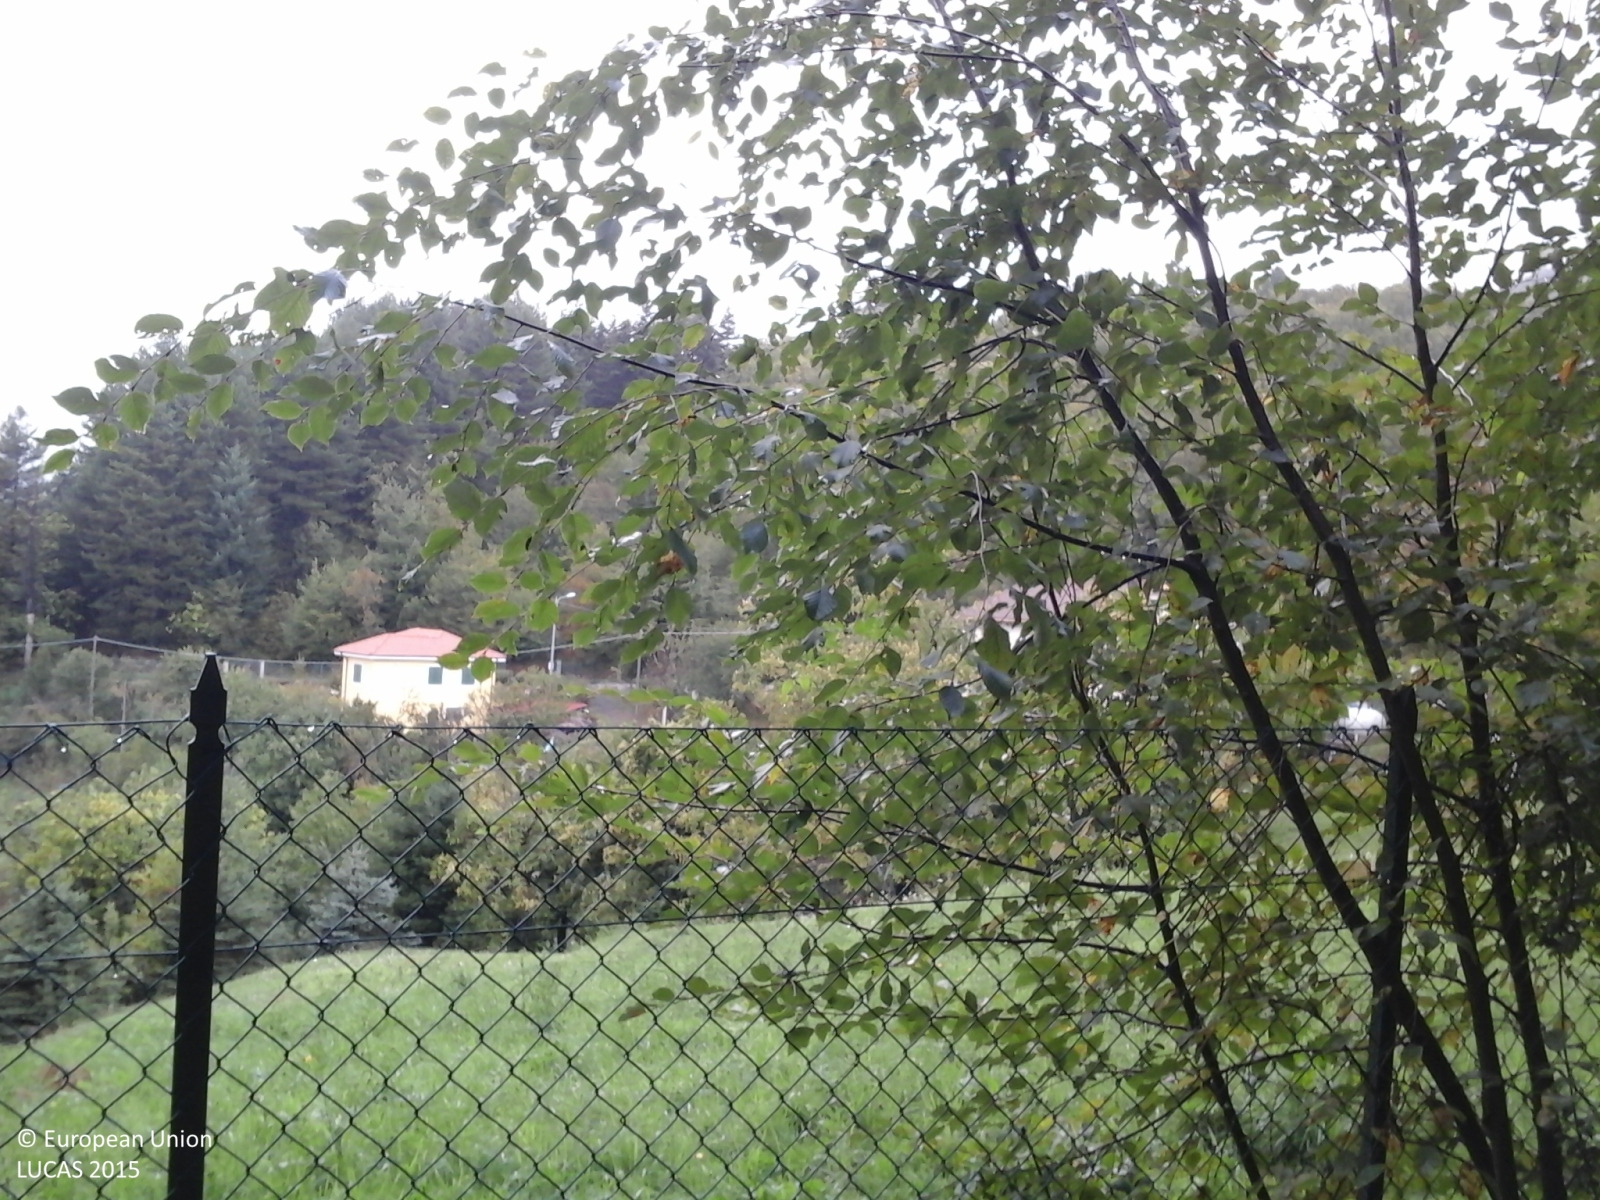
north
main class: Woodland
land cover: Other mixed woodland
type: coniferous forest of the mediterranean region
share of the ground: > 75 %
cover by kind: broadleaved forest trees 60 %, coniferous forest trees 30 %, herbaceous plants 10 %
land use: Semi-natural and natural areas not in use
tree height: > 5 m
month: September
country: IT
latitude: 44.4389
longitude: 9.3858
